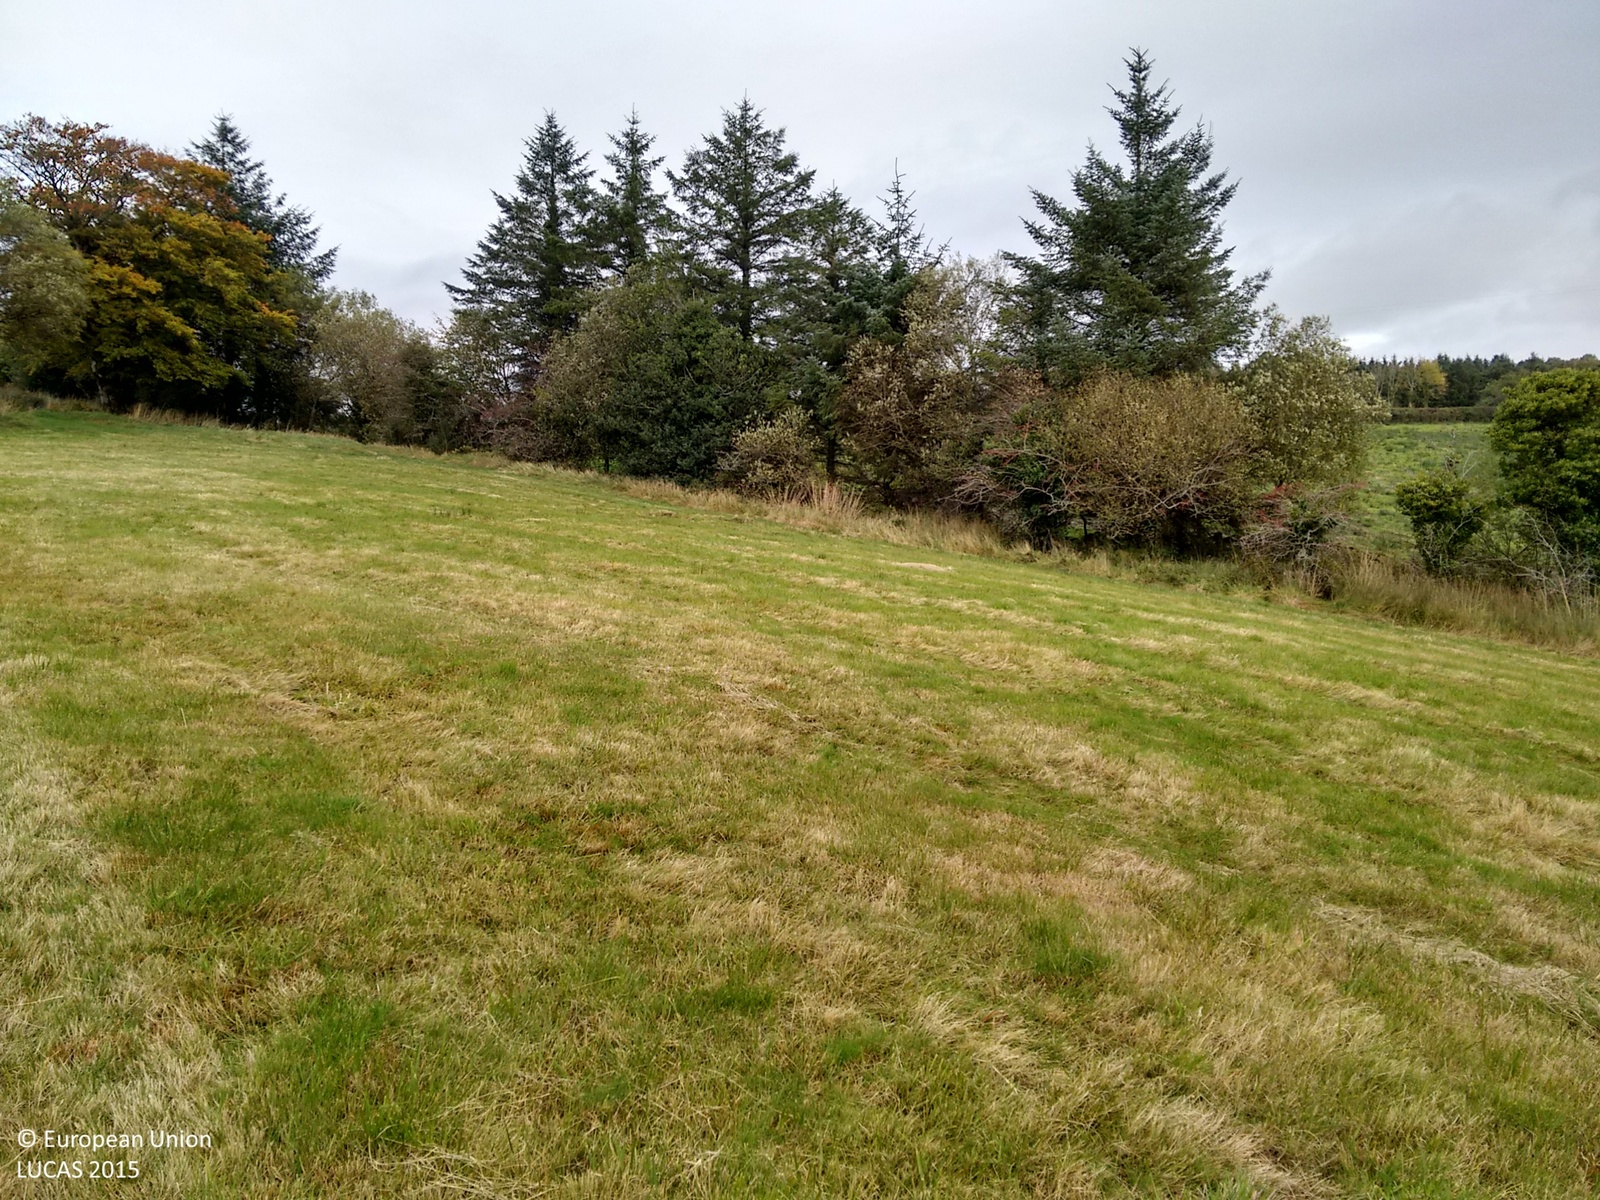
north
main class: Grassland
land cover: Grassland without tree/shrub cover
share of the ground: > 75 %
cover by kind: herbaceous plants 100 %
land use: Agriculture (excluding fallow land and kitchen gardens)
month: October
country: GB
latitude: 54.2660
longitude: -7.3952
